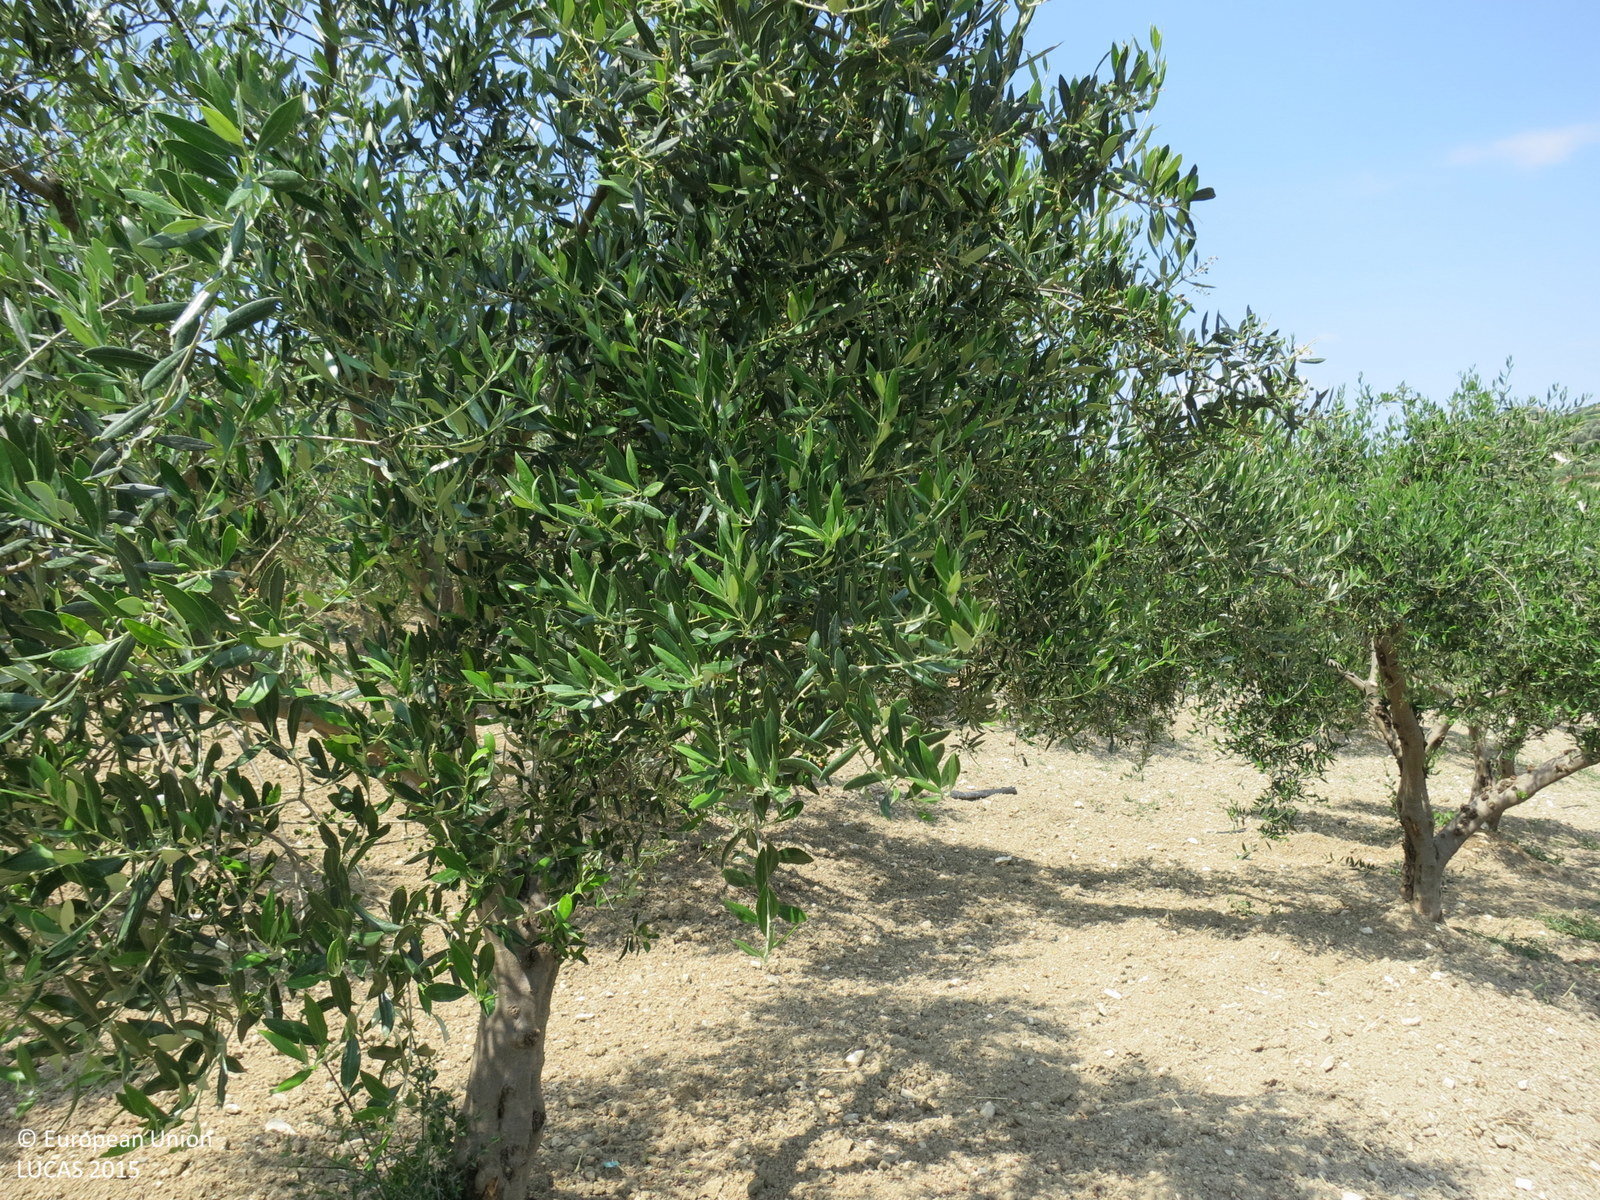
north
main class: Cropland
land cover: Olive groves
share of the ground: 25 - 50 %
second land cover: Other bare soil
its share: > 75 %
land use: Agriculture (excluding fallow land and kitchen gardens)
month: June
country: GR
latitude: 35.2225
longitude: 25.0083
